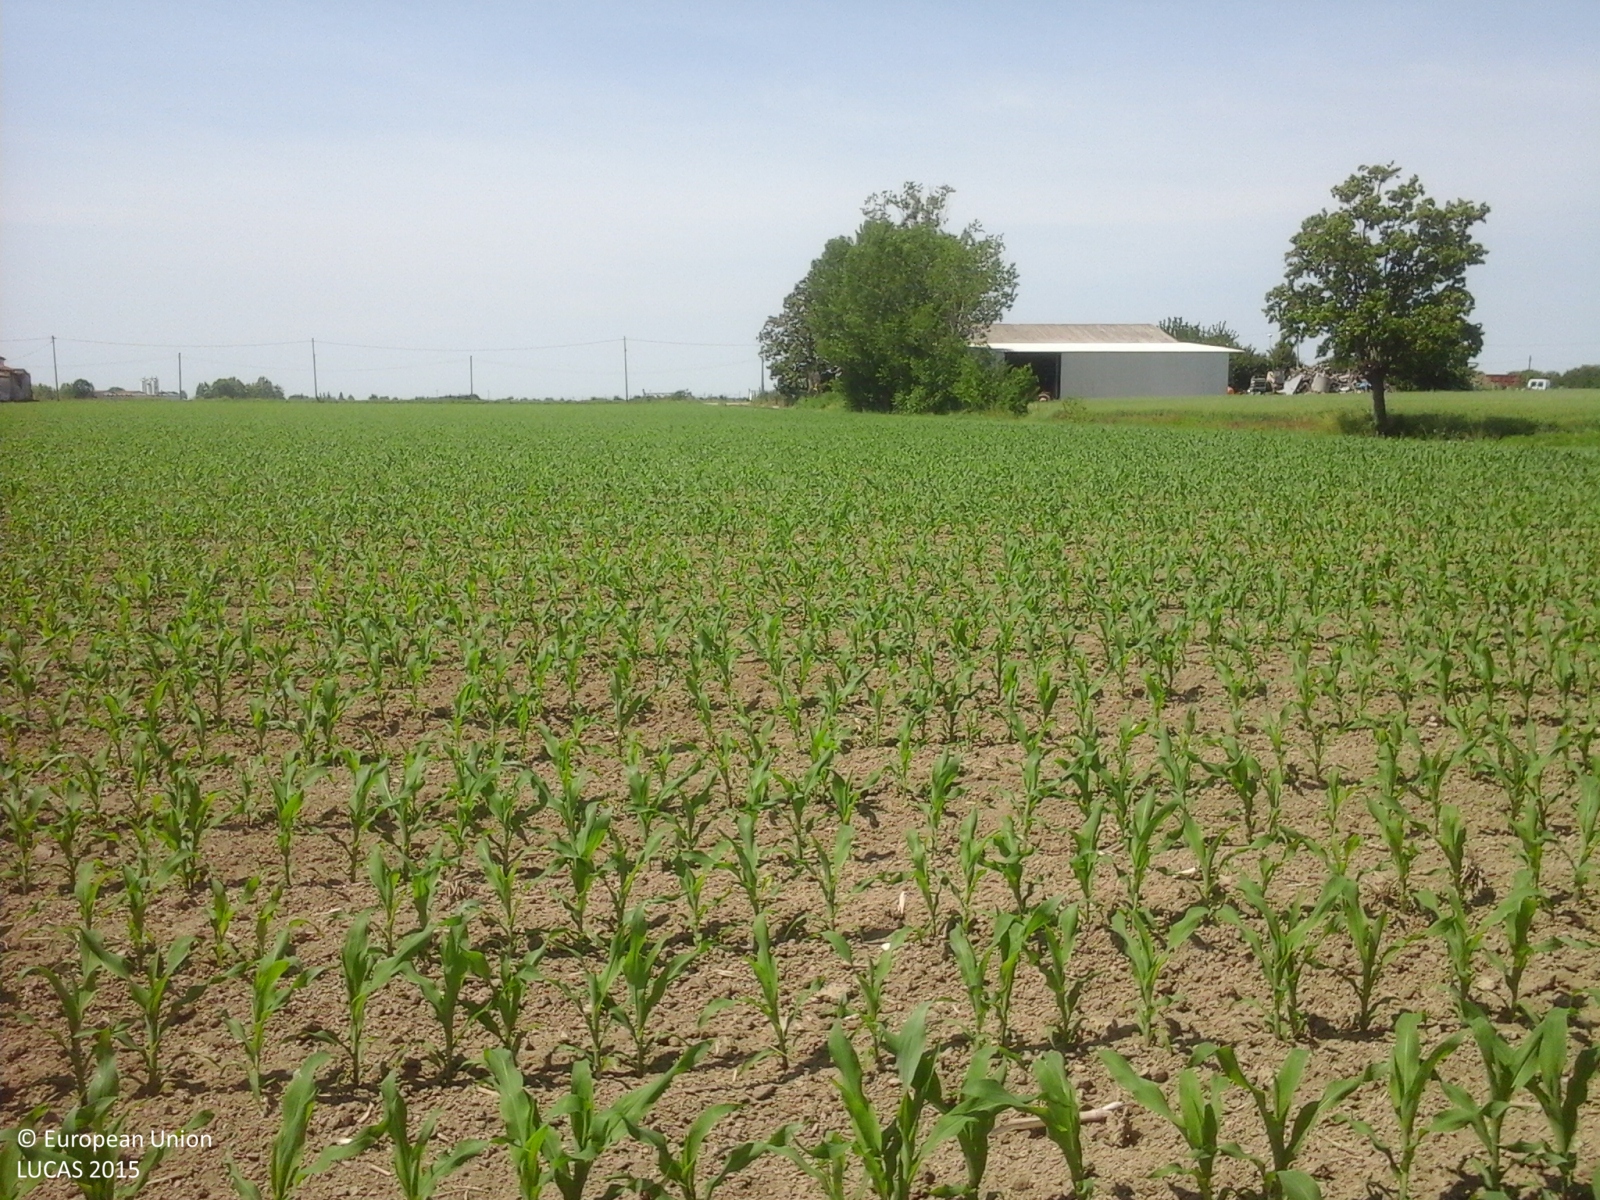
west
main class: Cropland
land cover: Maize
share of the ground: 10 - 25 %
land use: Agriculture (excluding fallow land and kitchen gardens)
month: May
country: IT
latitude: 44.9317
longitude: 11.7073
